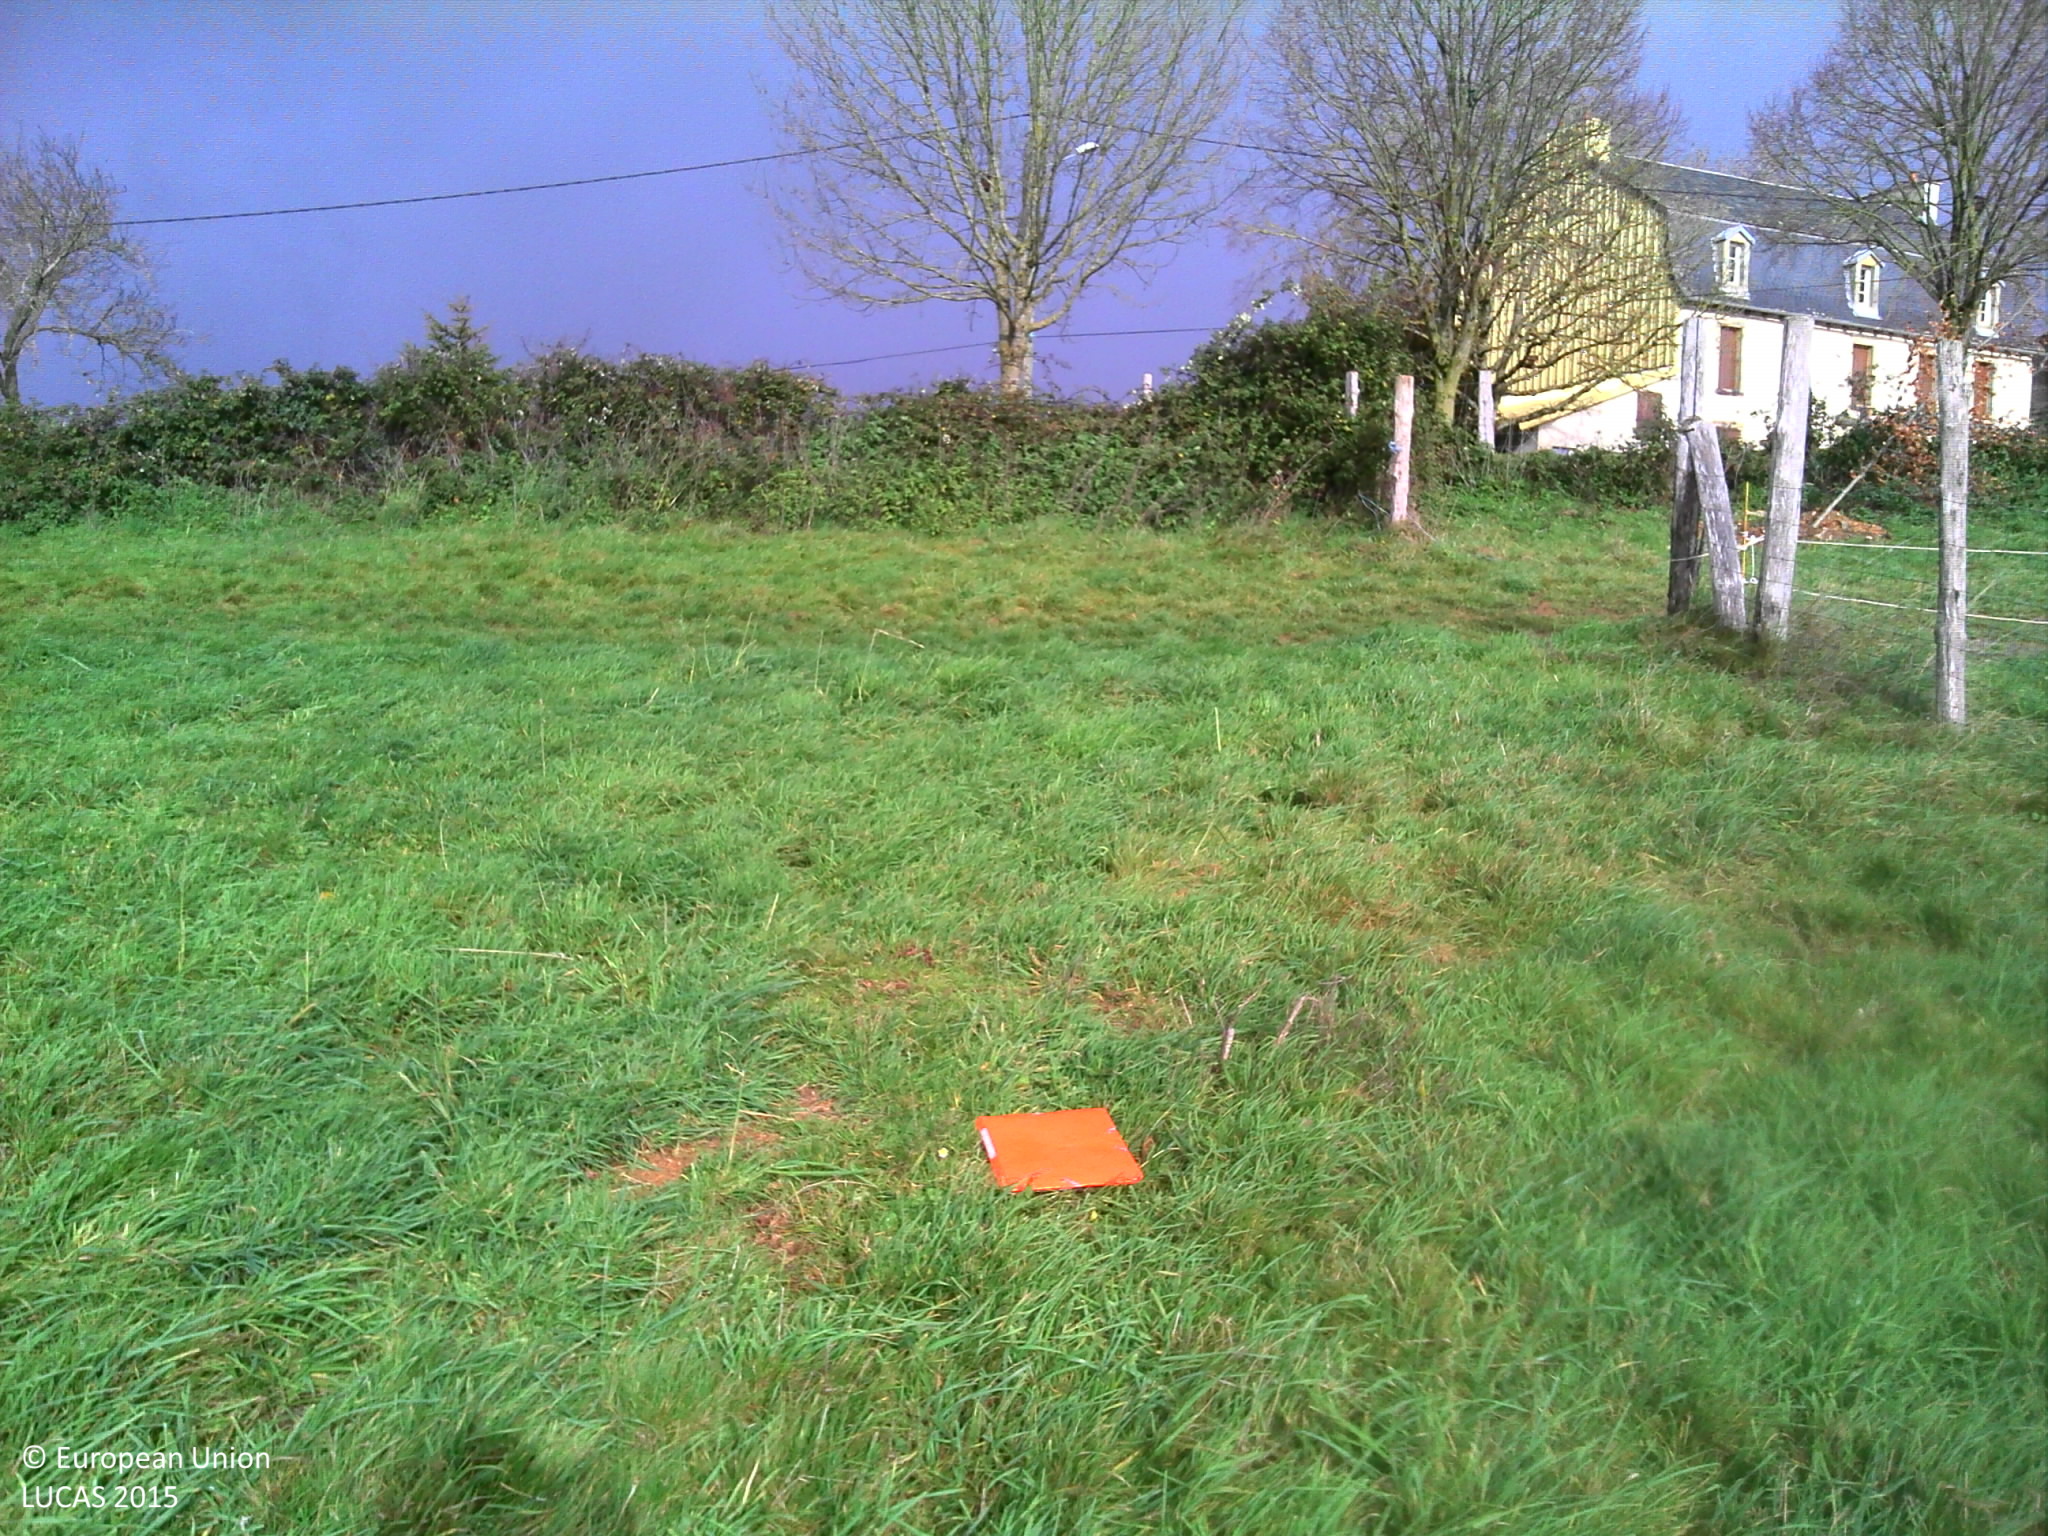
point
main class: Grassland
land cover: Grassland without tree/shrub cover
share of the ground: > 75 %
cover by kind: herbaceous plants 100 %
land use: Agriculture (excluding fallow land and kitchen gardens)
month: November
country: FR
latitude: 44.0681
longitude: 2.6010
